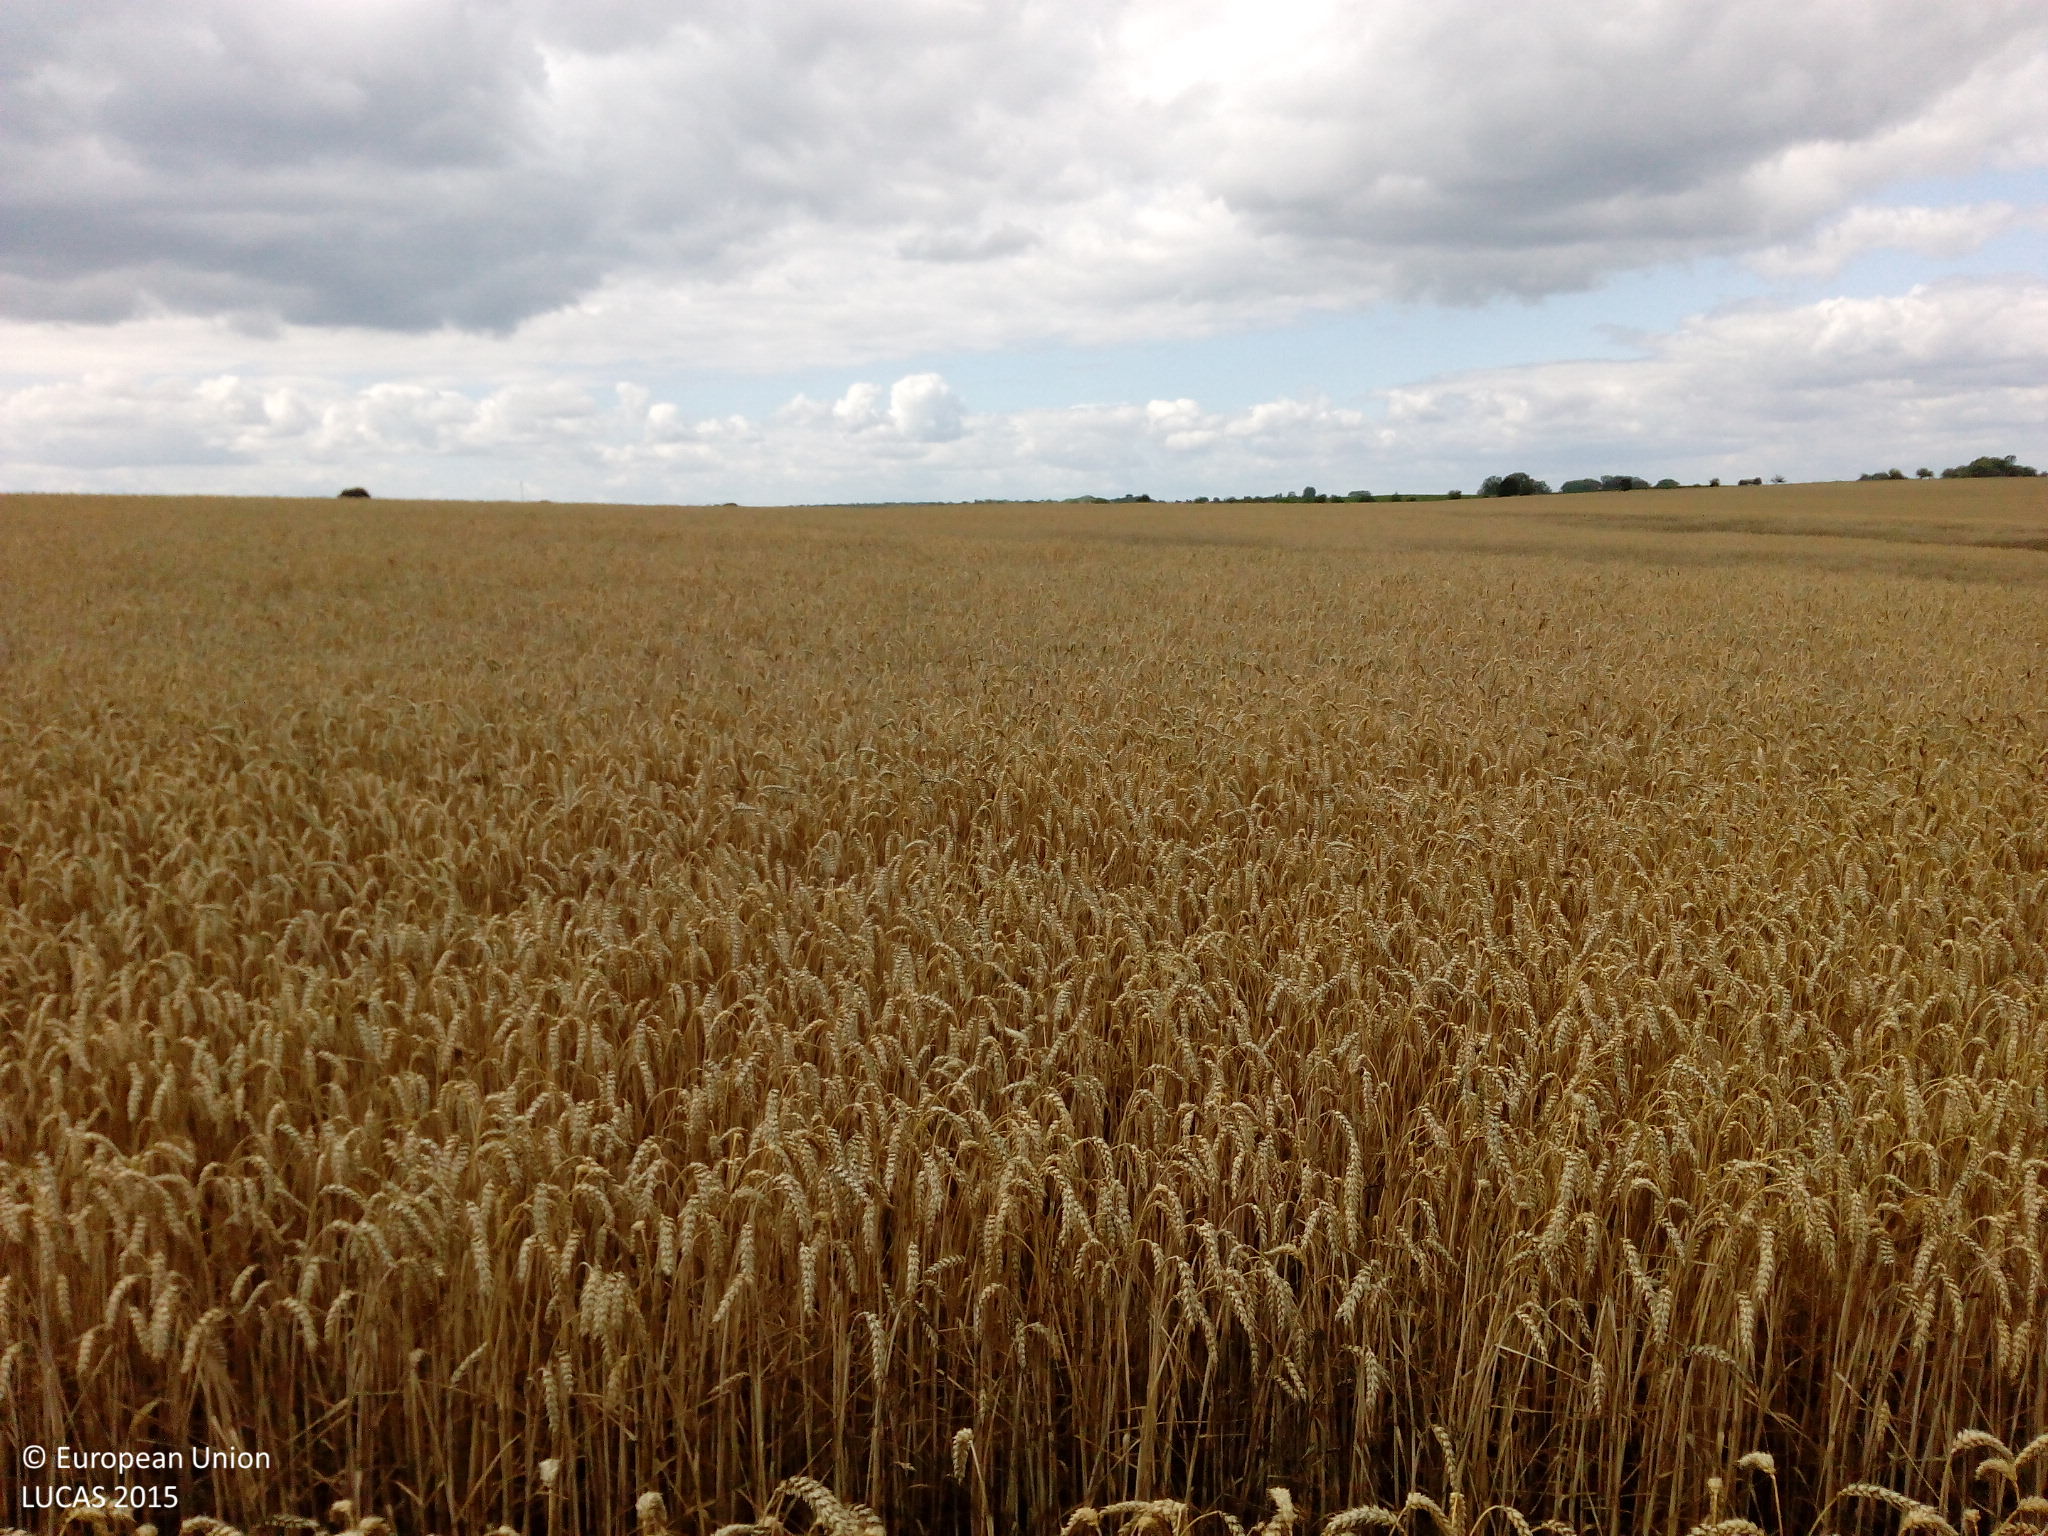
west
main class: Cropland
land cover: Common wheat
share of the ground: > 75 %
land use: Agriculture (excluding fallow land and kitchen gardens)
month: July
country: DE
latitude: 52.6109
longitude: 14.1508
